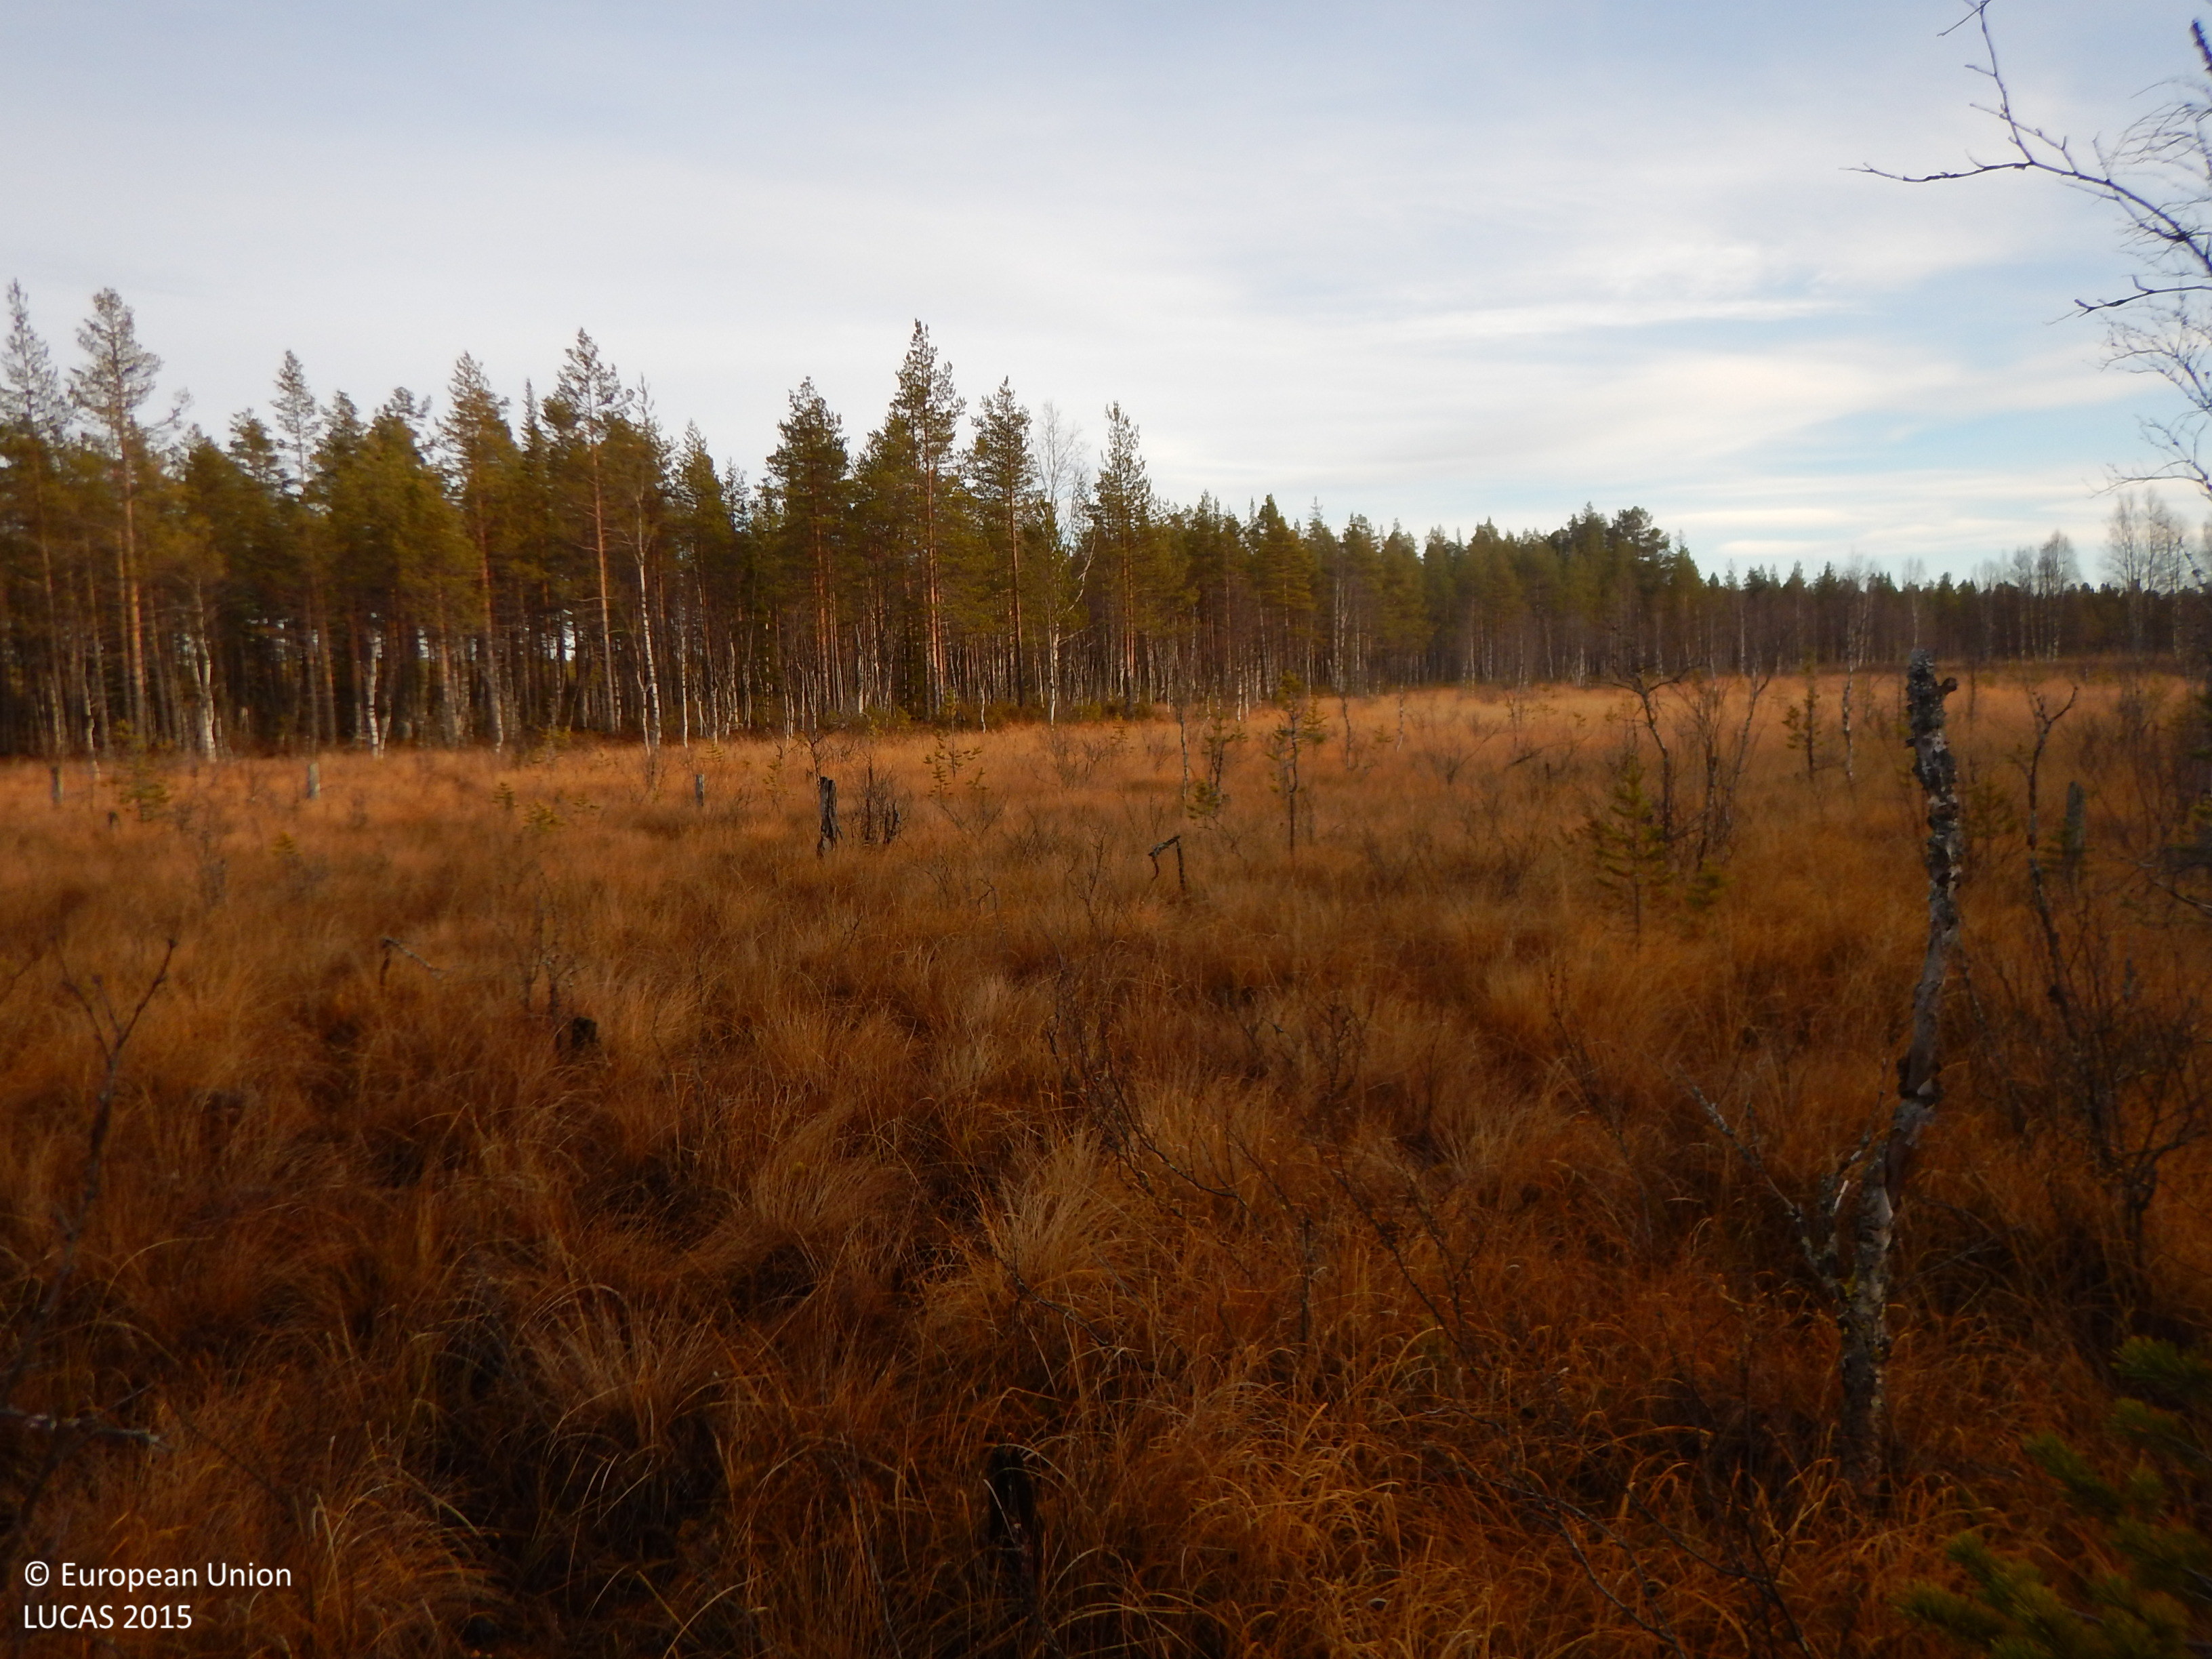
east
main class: Woodland
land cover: Pine dominated mixed woodland
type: mire and swamp forests
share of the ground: 10 - 25 %
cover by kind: herbaceous plants 60 %, coniferous forest trees 10 %, broadleaved forest trees 10 %, shrubs 10 %, lichens and mosses 10 %
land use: Semi-natural and natural areas not in use
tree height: > 5 m
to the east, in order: Pine dominated mixed woodland; Peatbogs; Pine dominated mixed woodland; Pine dominated coniferous woodland
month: October
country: SE
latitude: 65.3248
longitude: 20.2504
